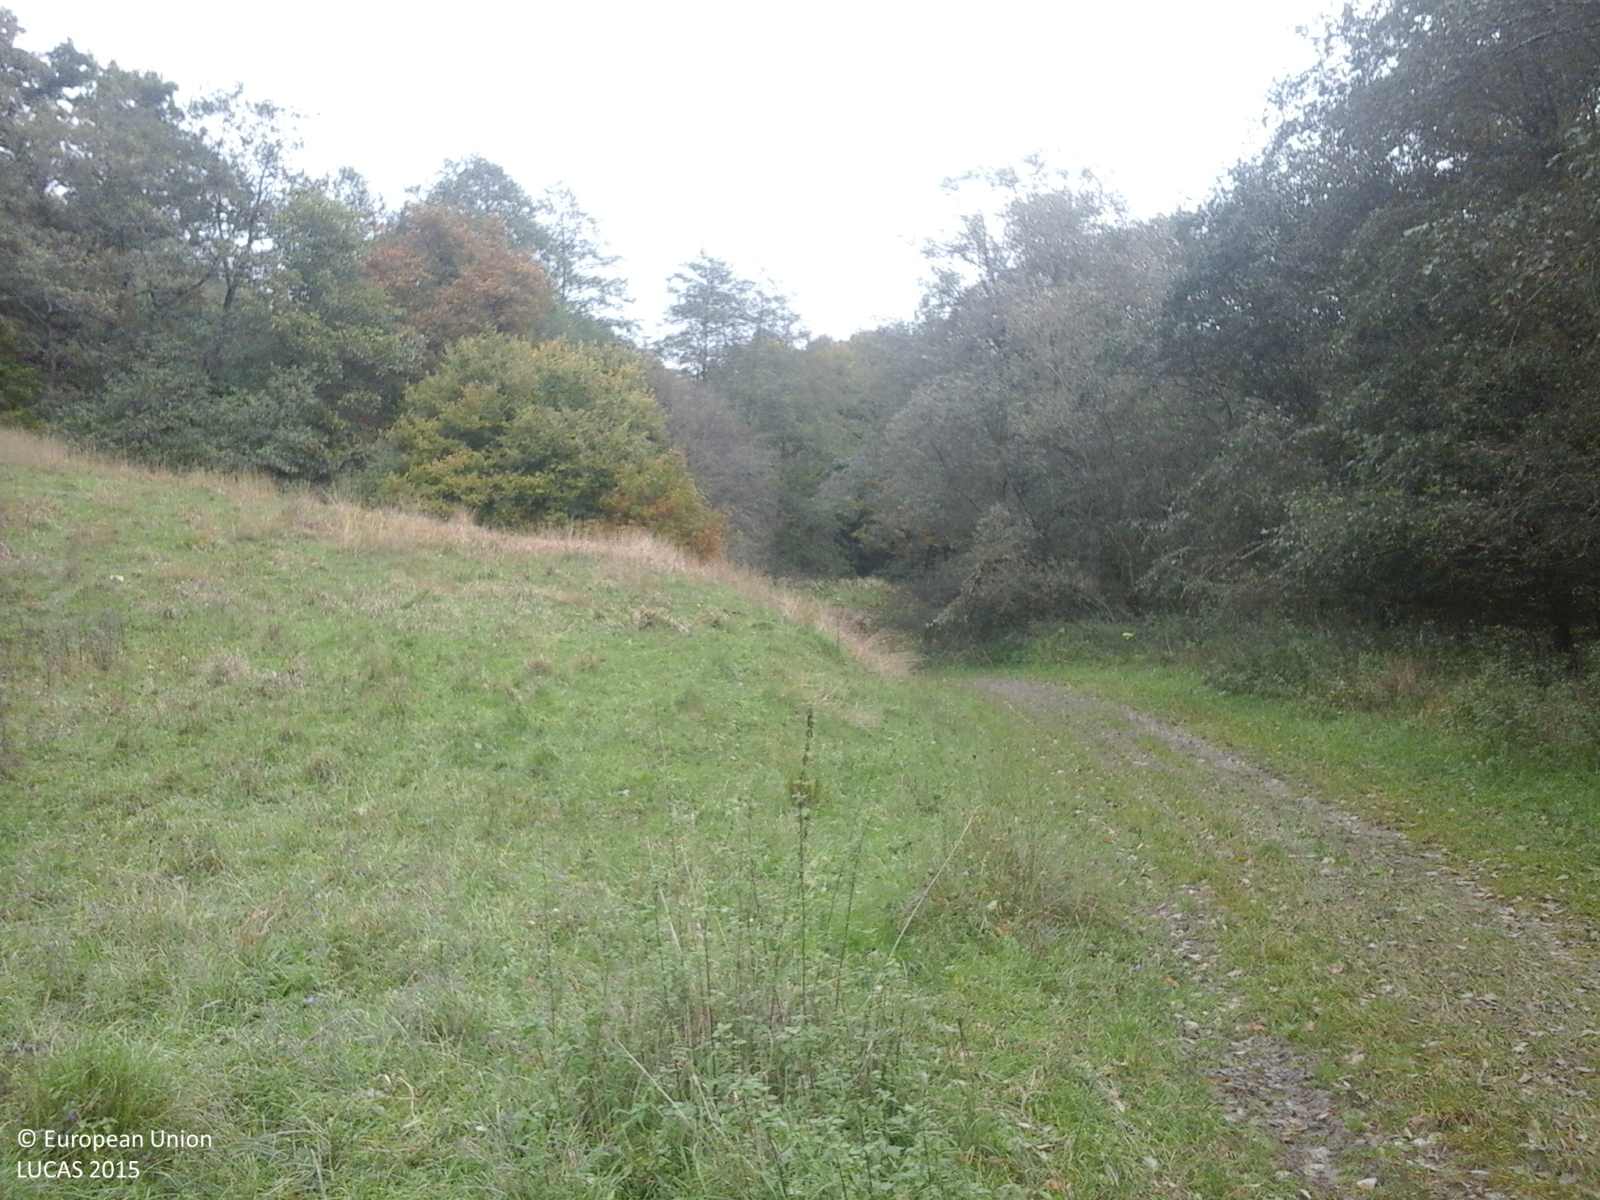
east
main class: Grassland
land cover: Grassland without tree/shrub cover
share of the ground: > 75 %
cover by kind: herbaceous plants 100 %
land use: Agriculture (excluding fallow land and kitchen gardens)
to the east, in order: Grassland without tree/shrub cover; Broadleaved woodland; Grassland with sparse tree/shrub cover; Broadleaved woodland; Grassland with sparse tree/shrub cover; Broadleaved woodland; Grassland without tree/shrub cover
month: October
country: RO
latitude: 45.8515
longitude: 24.7555
